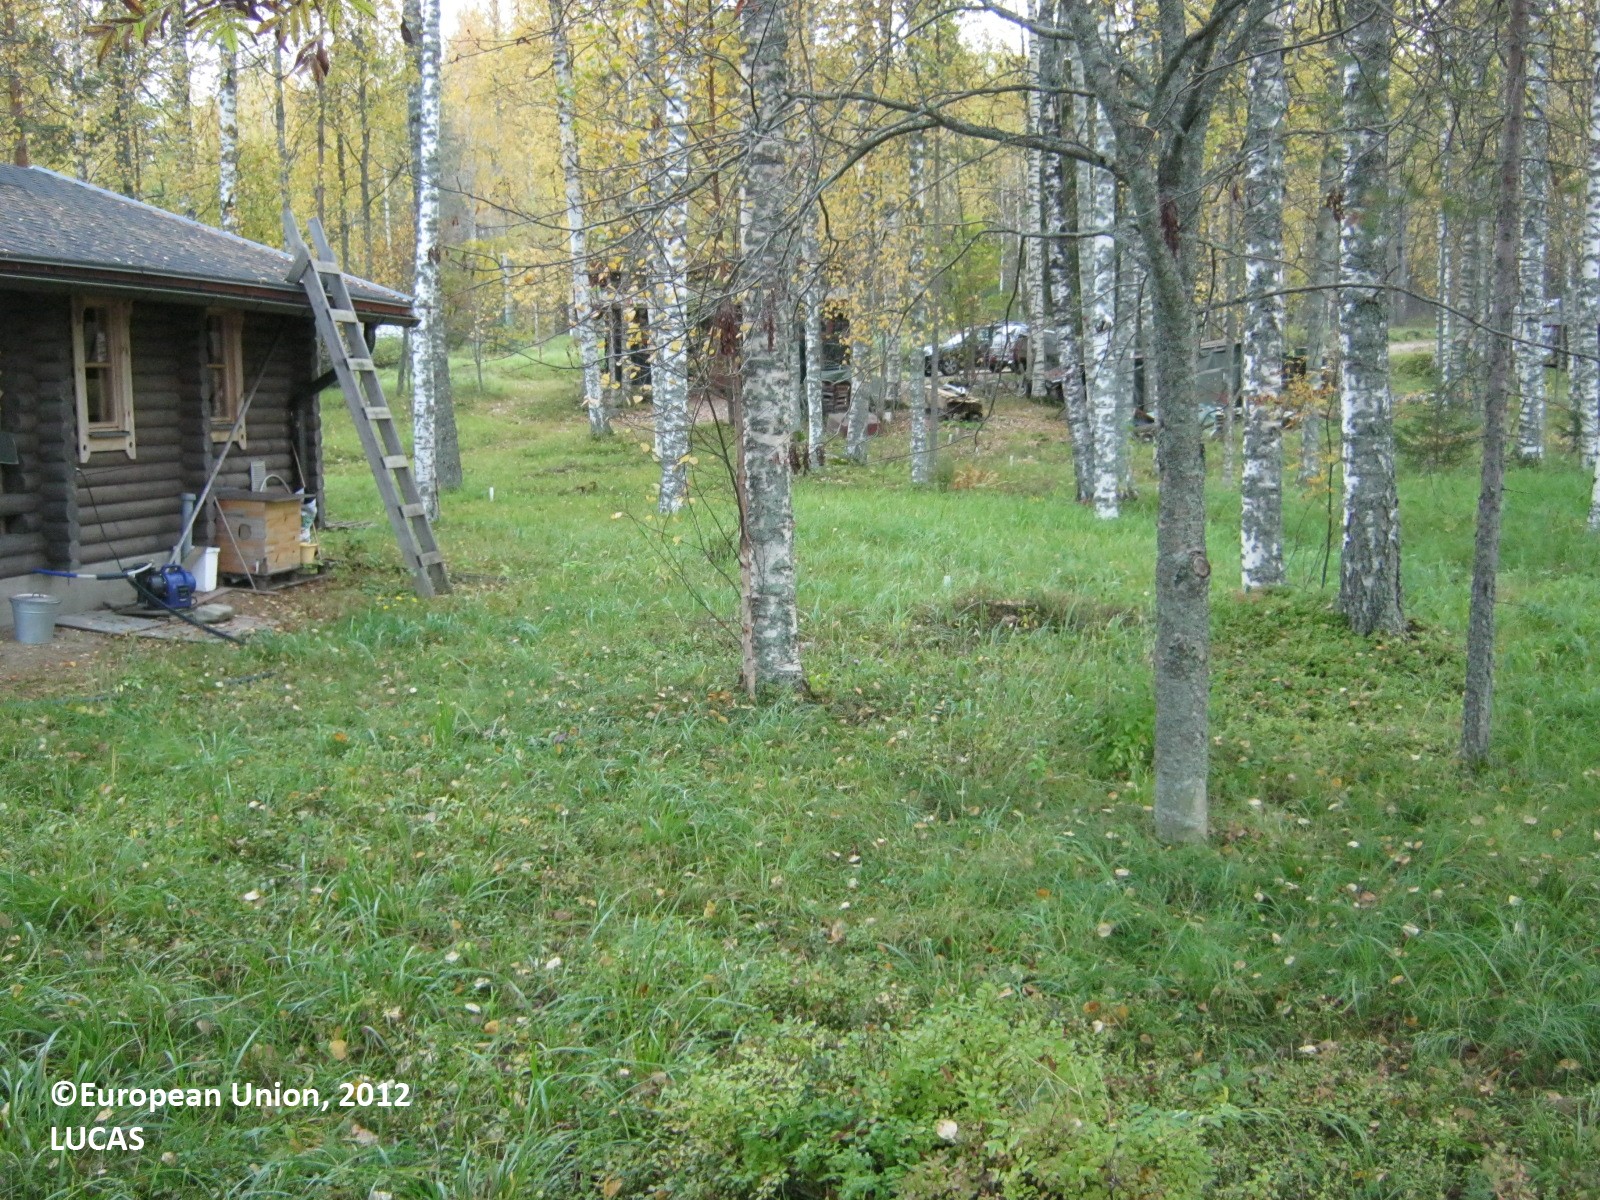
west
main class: Woodland
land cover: Other mixed woodland
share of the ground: 25 - 50 %
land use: Residential
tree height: > 5 m
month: September
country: FI
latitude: 62.3283
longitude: 28.7617
